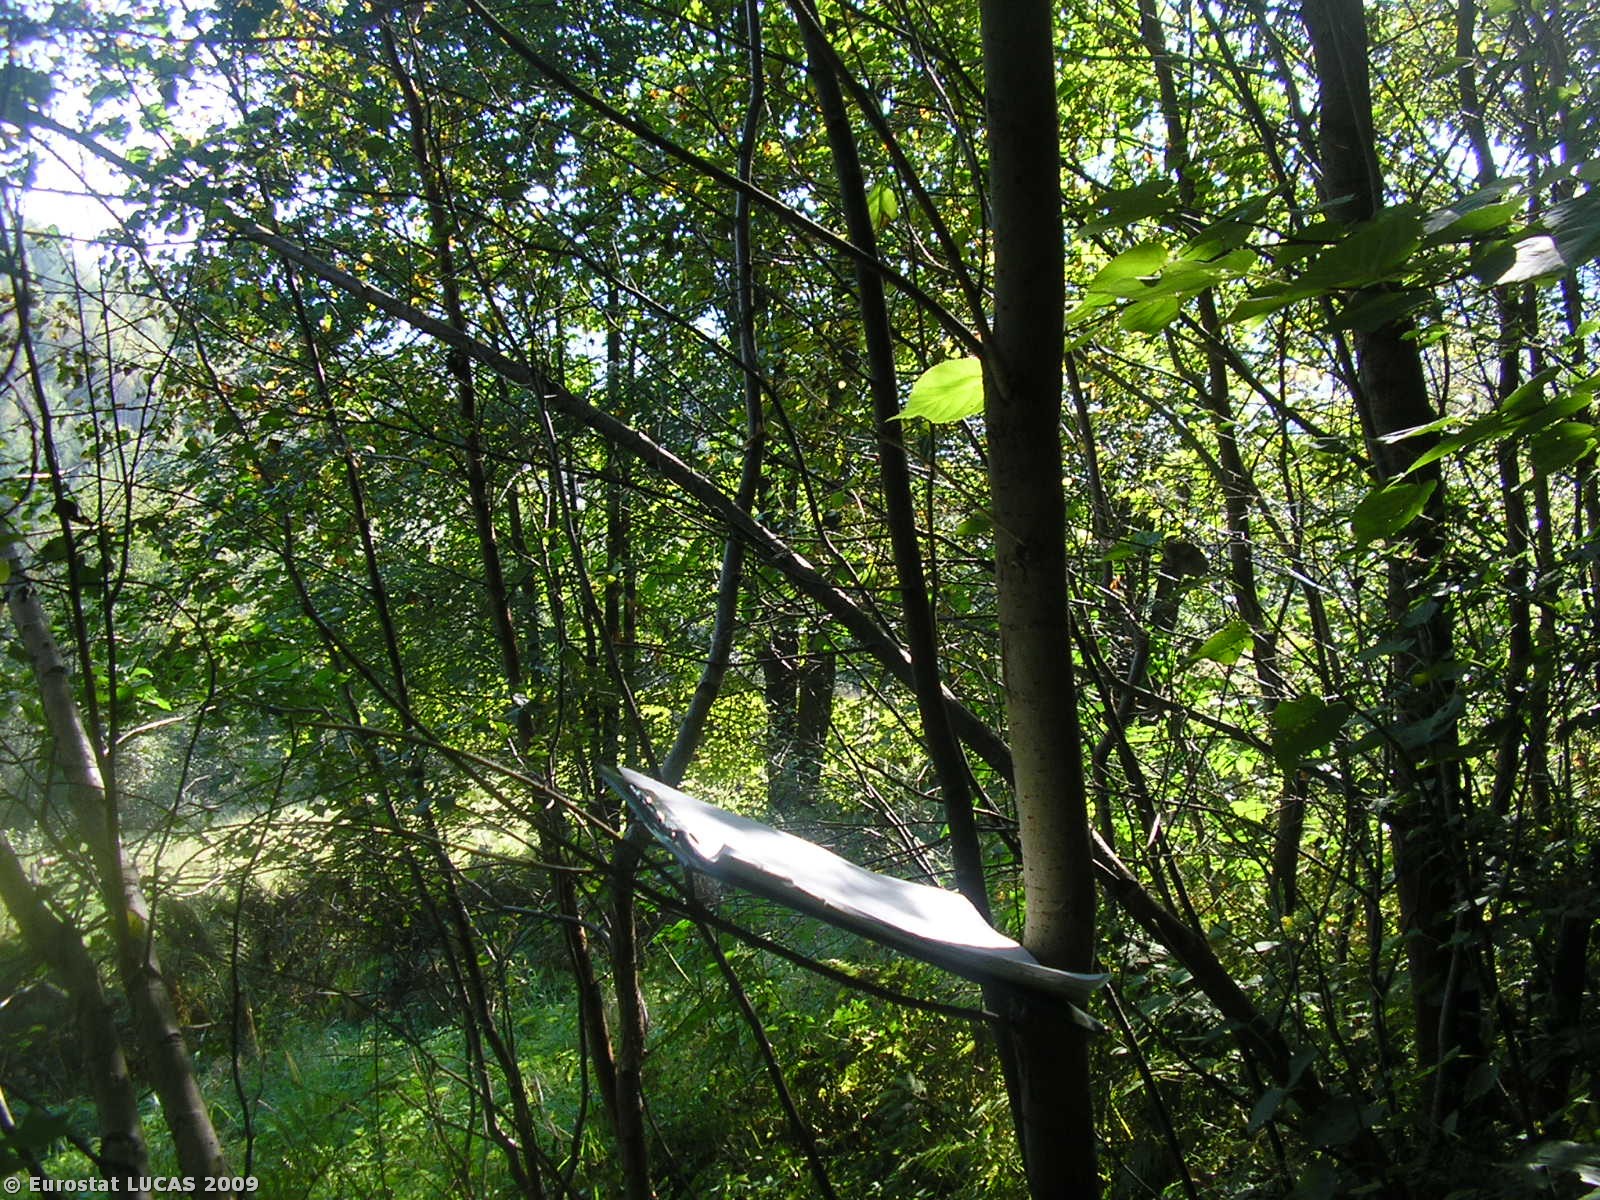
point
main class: Woodland
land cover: Broadleaved woodland
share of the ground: > 75 %
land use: Unused
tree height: < 5 m
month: September
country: PL
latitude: 49.6718
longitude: 19.5749
